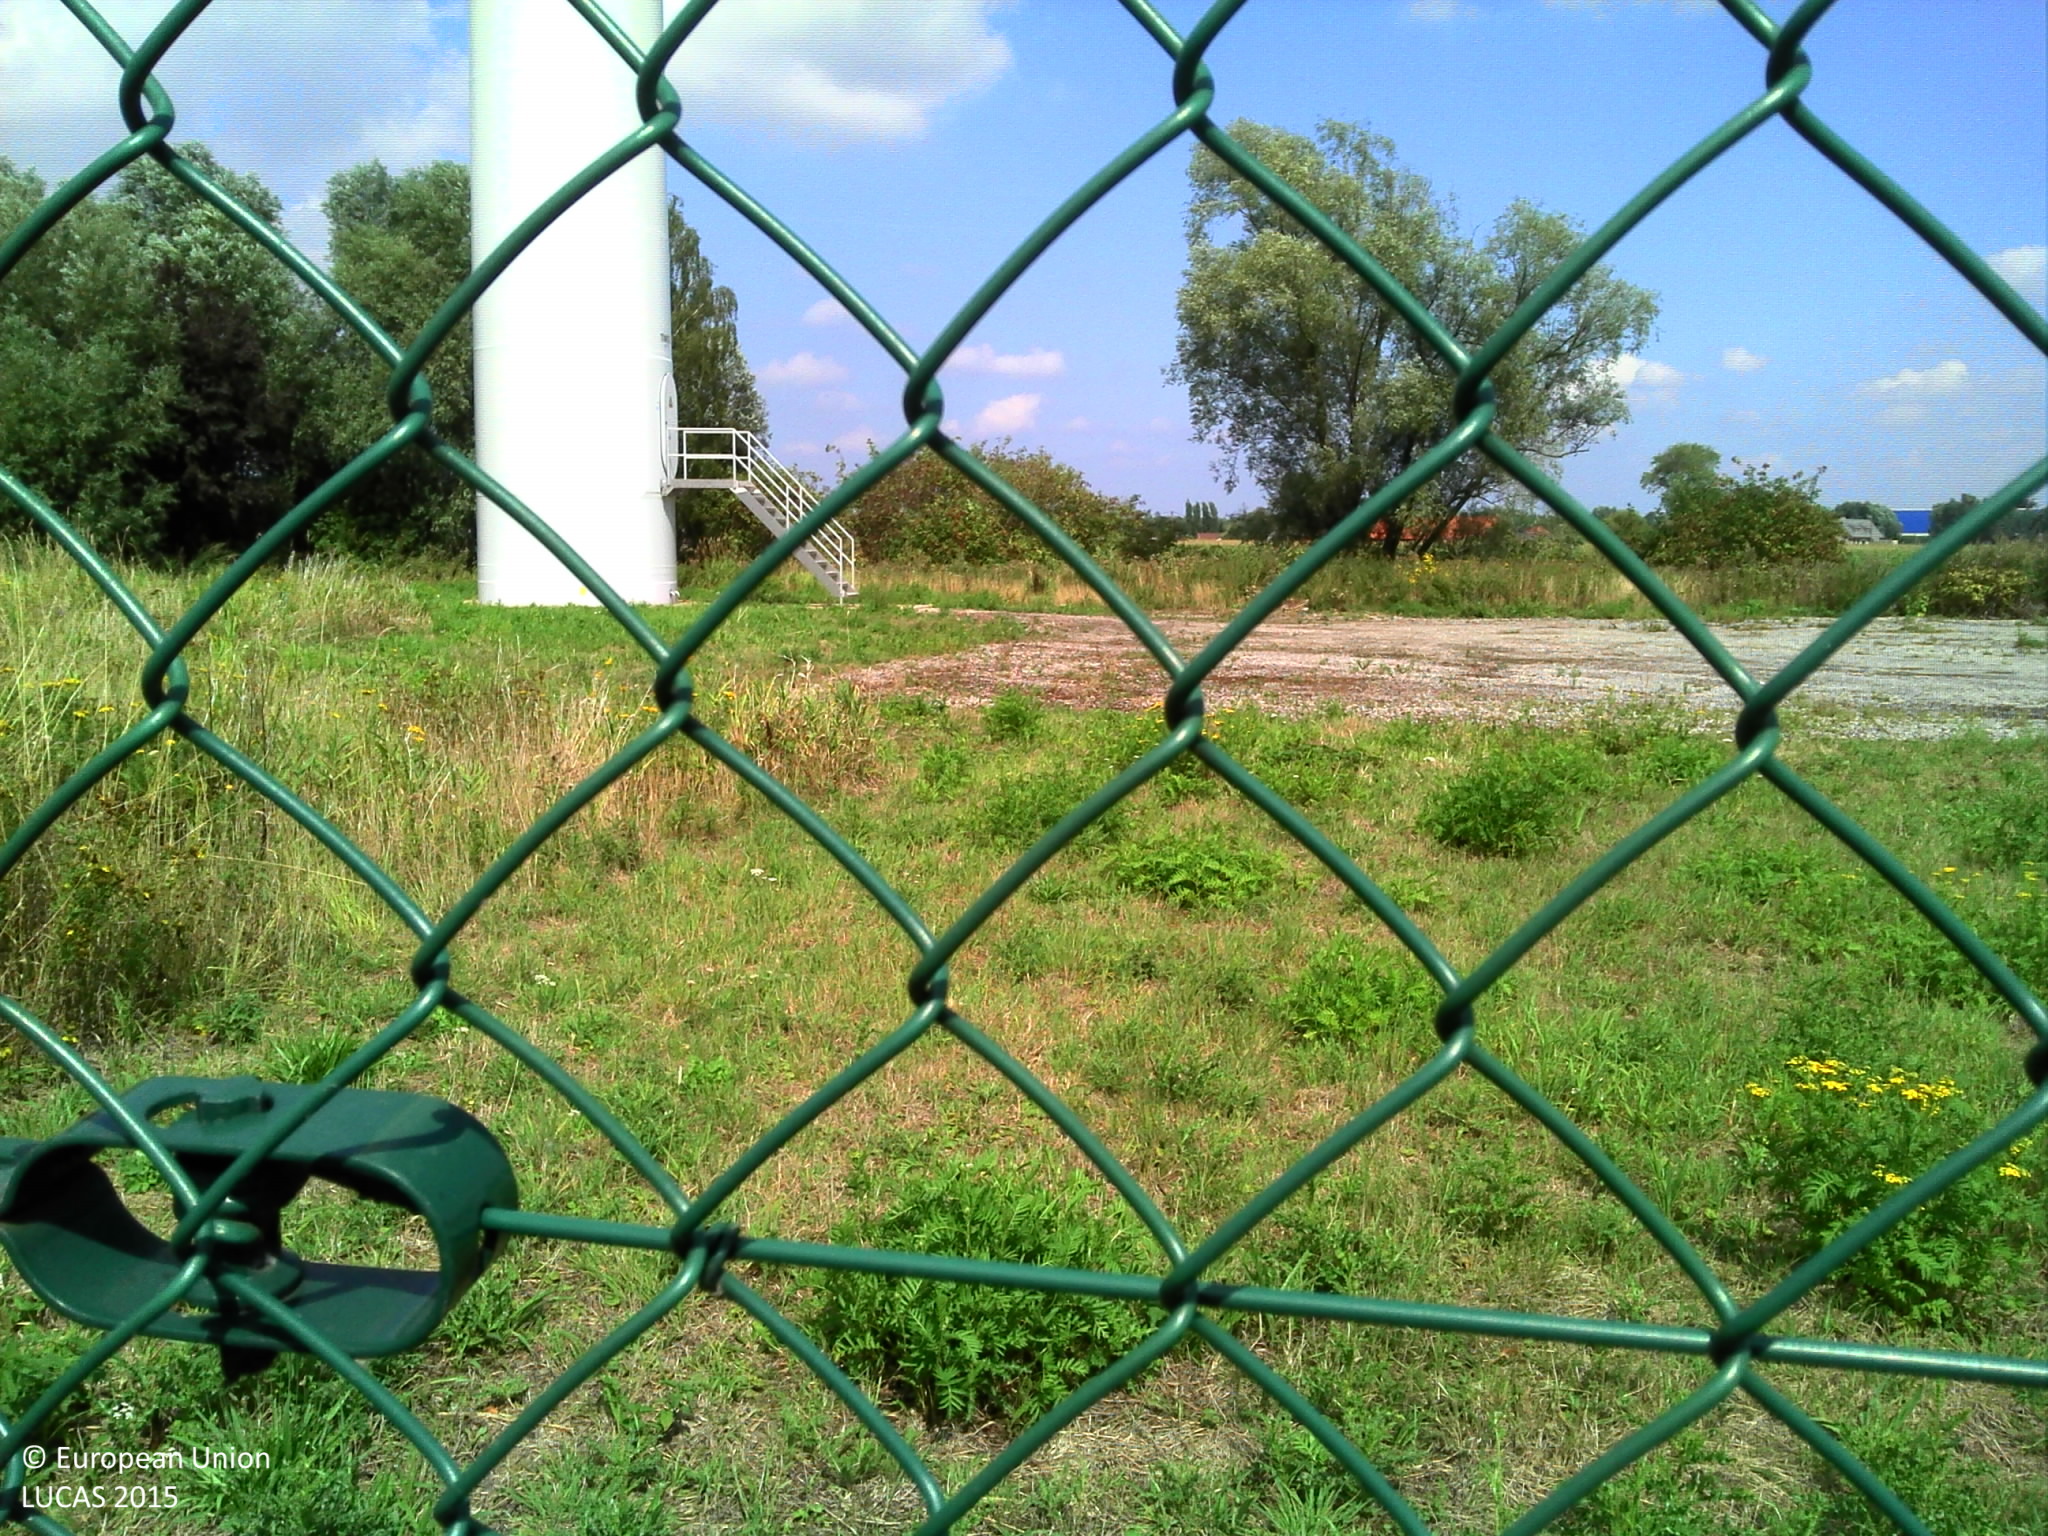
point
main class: Grassland
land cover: Spontaneously vegetated surfaces
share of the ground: > 75 %
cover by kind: herbaceous plants 80 %, unconsolidated bare surface 20 %
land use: Energy production
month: August
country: BE
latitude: 50.9361
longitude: 3.1745
